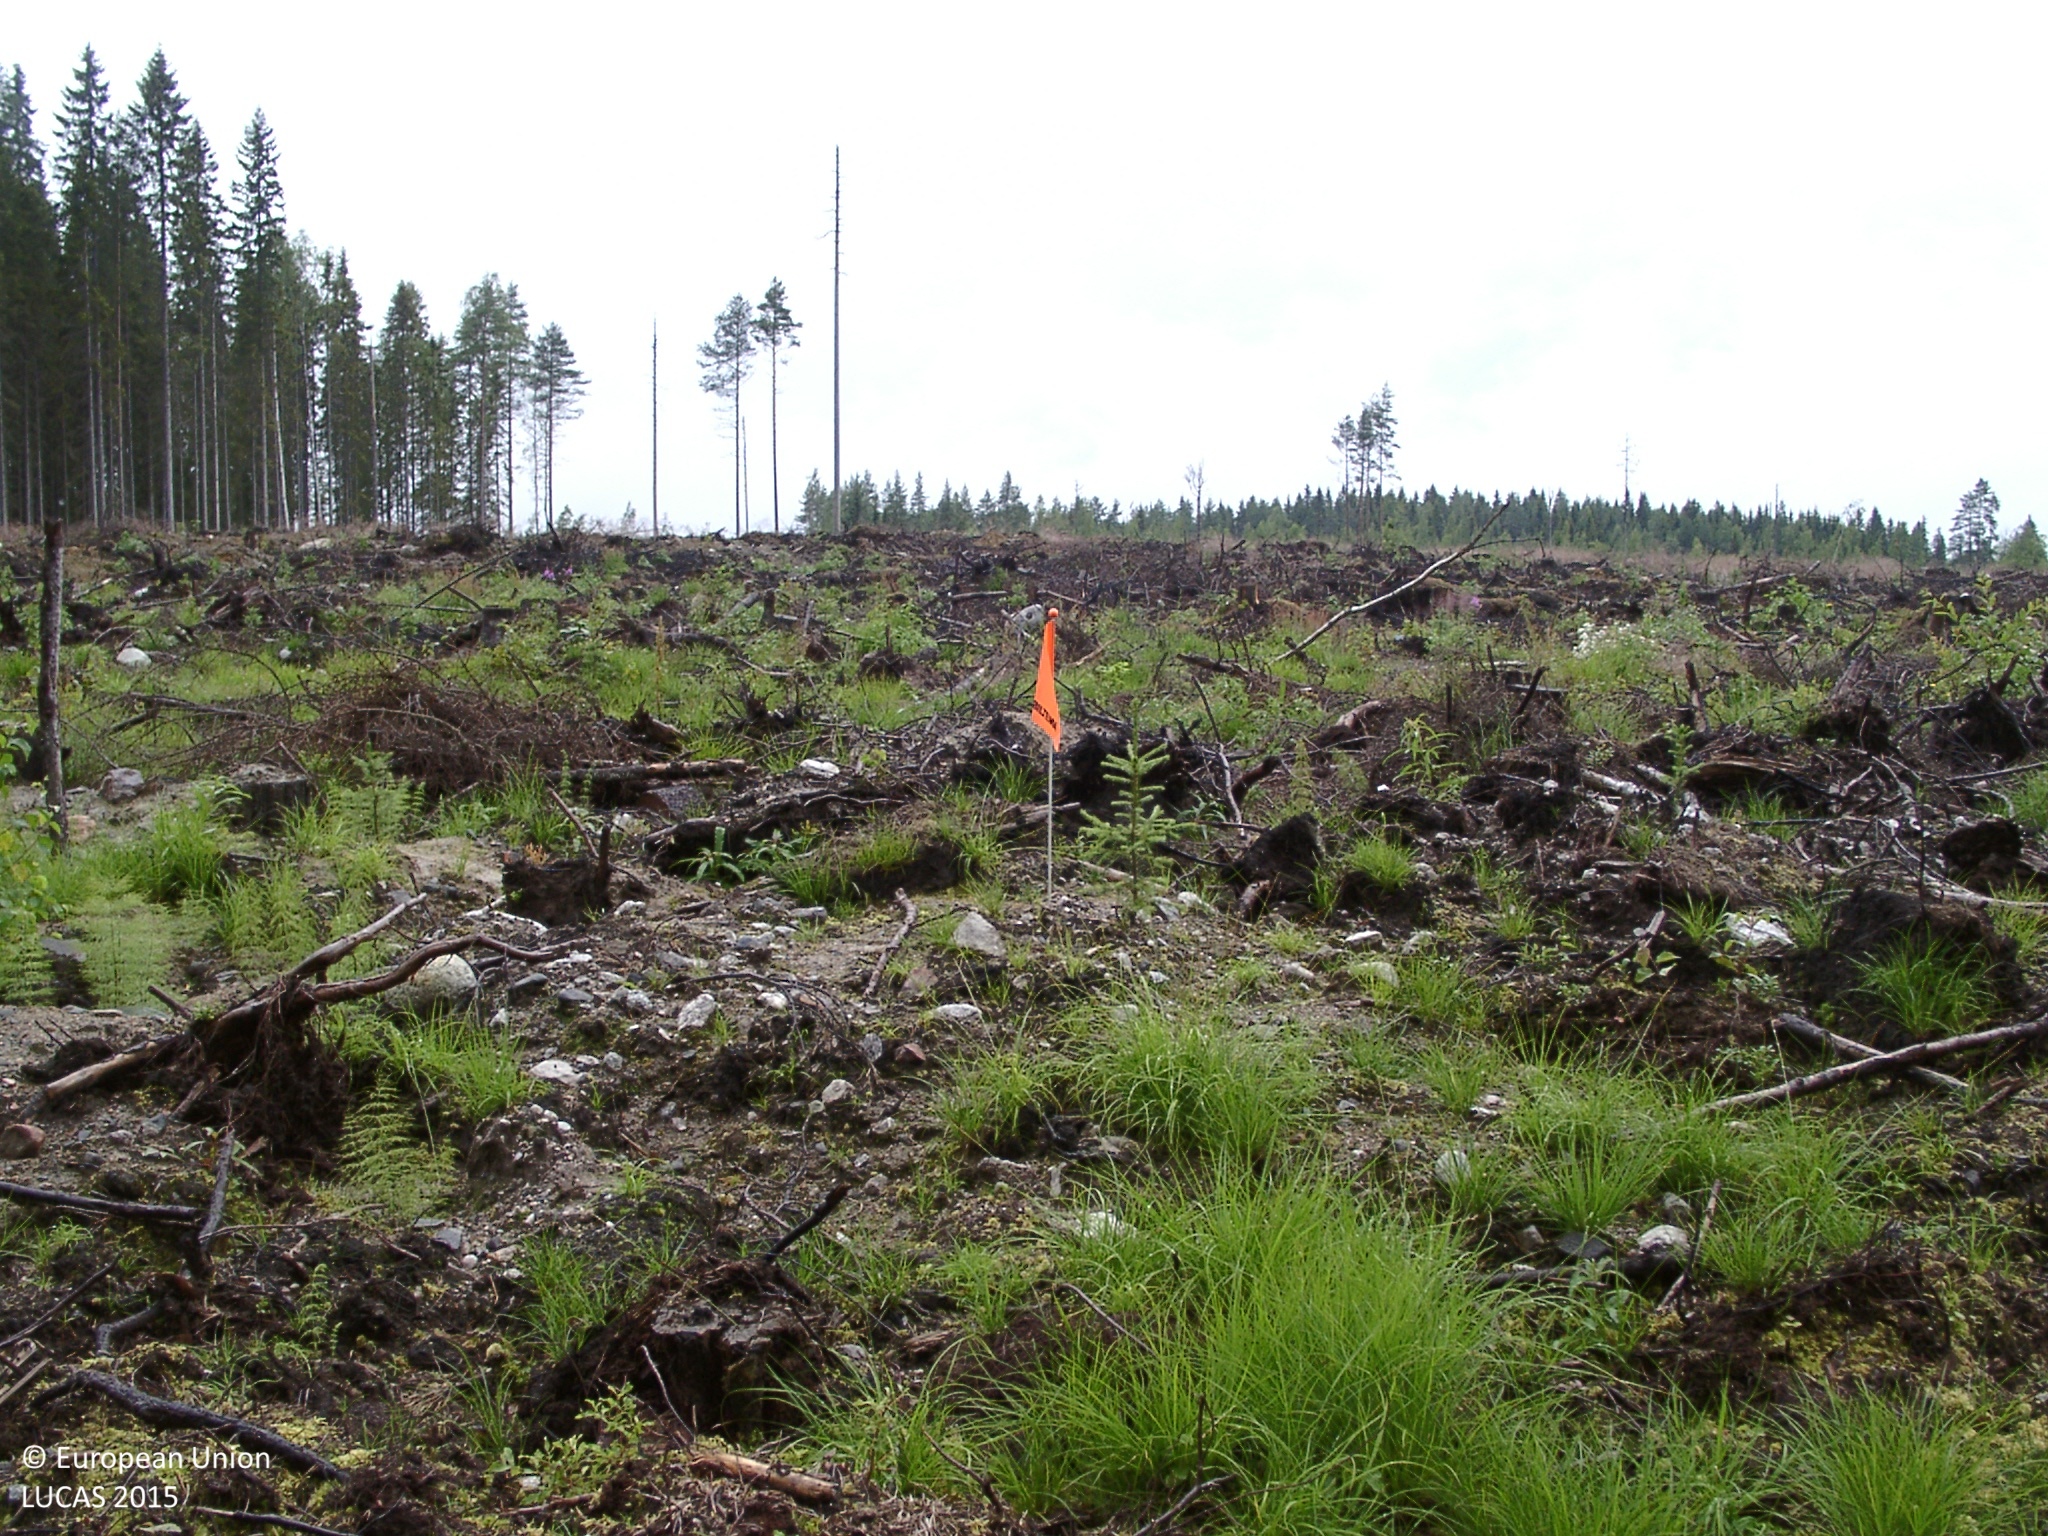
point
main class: Grassland
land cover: Grassland with sparse tree/shrub cover
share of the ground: 25 - 50 %
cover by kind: herbaceous plants 25 %, unconsolidated bare surface 25 %, lichens and mosses 10 %, broadleaved forest trees 5 %
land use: Forestry
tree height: < 5 m
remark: Nursery
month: August
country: FI
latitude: 62.8128
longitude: 24.6264
